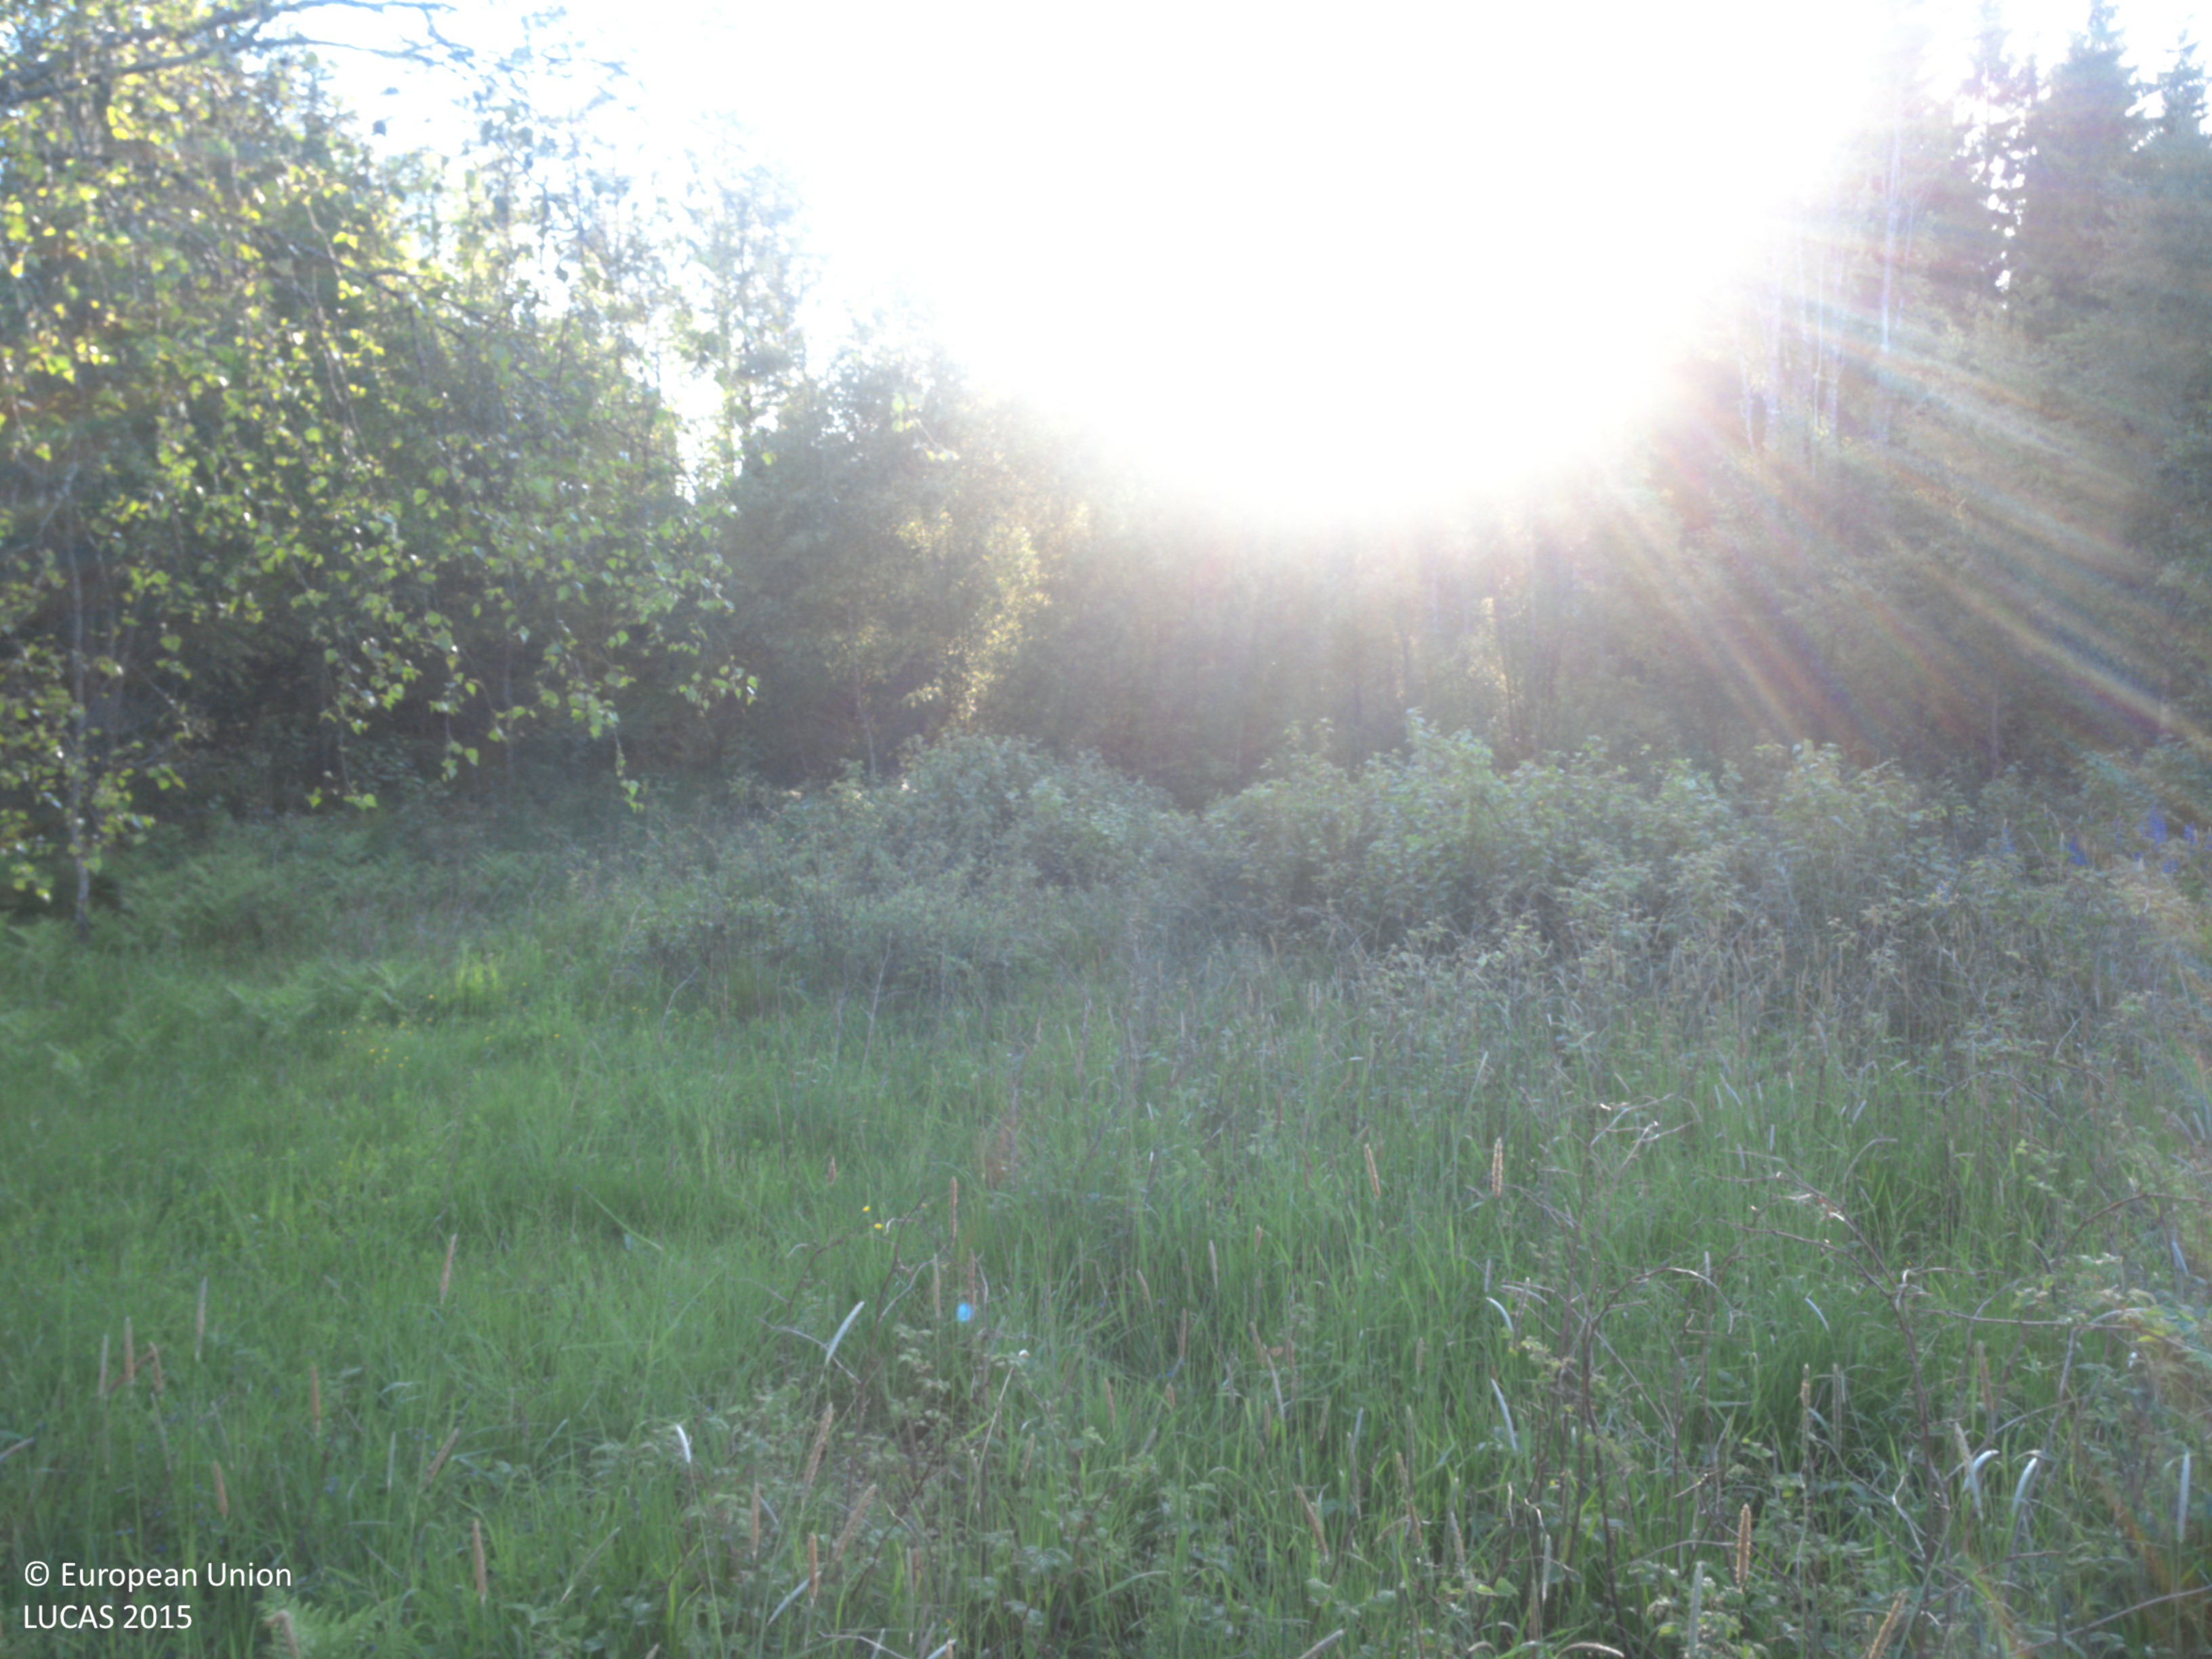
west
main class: Grassland
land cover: Spontaneously vegetated surfaces
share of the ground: > 75 %
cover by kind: herbaceous plants 95 %, shrubs 5 %
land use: Fallow land
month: June
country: SE
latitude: 58.9628
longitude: 11.8215
